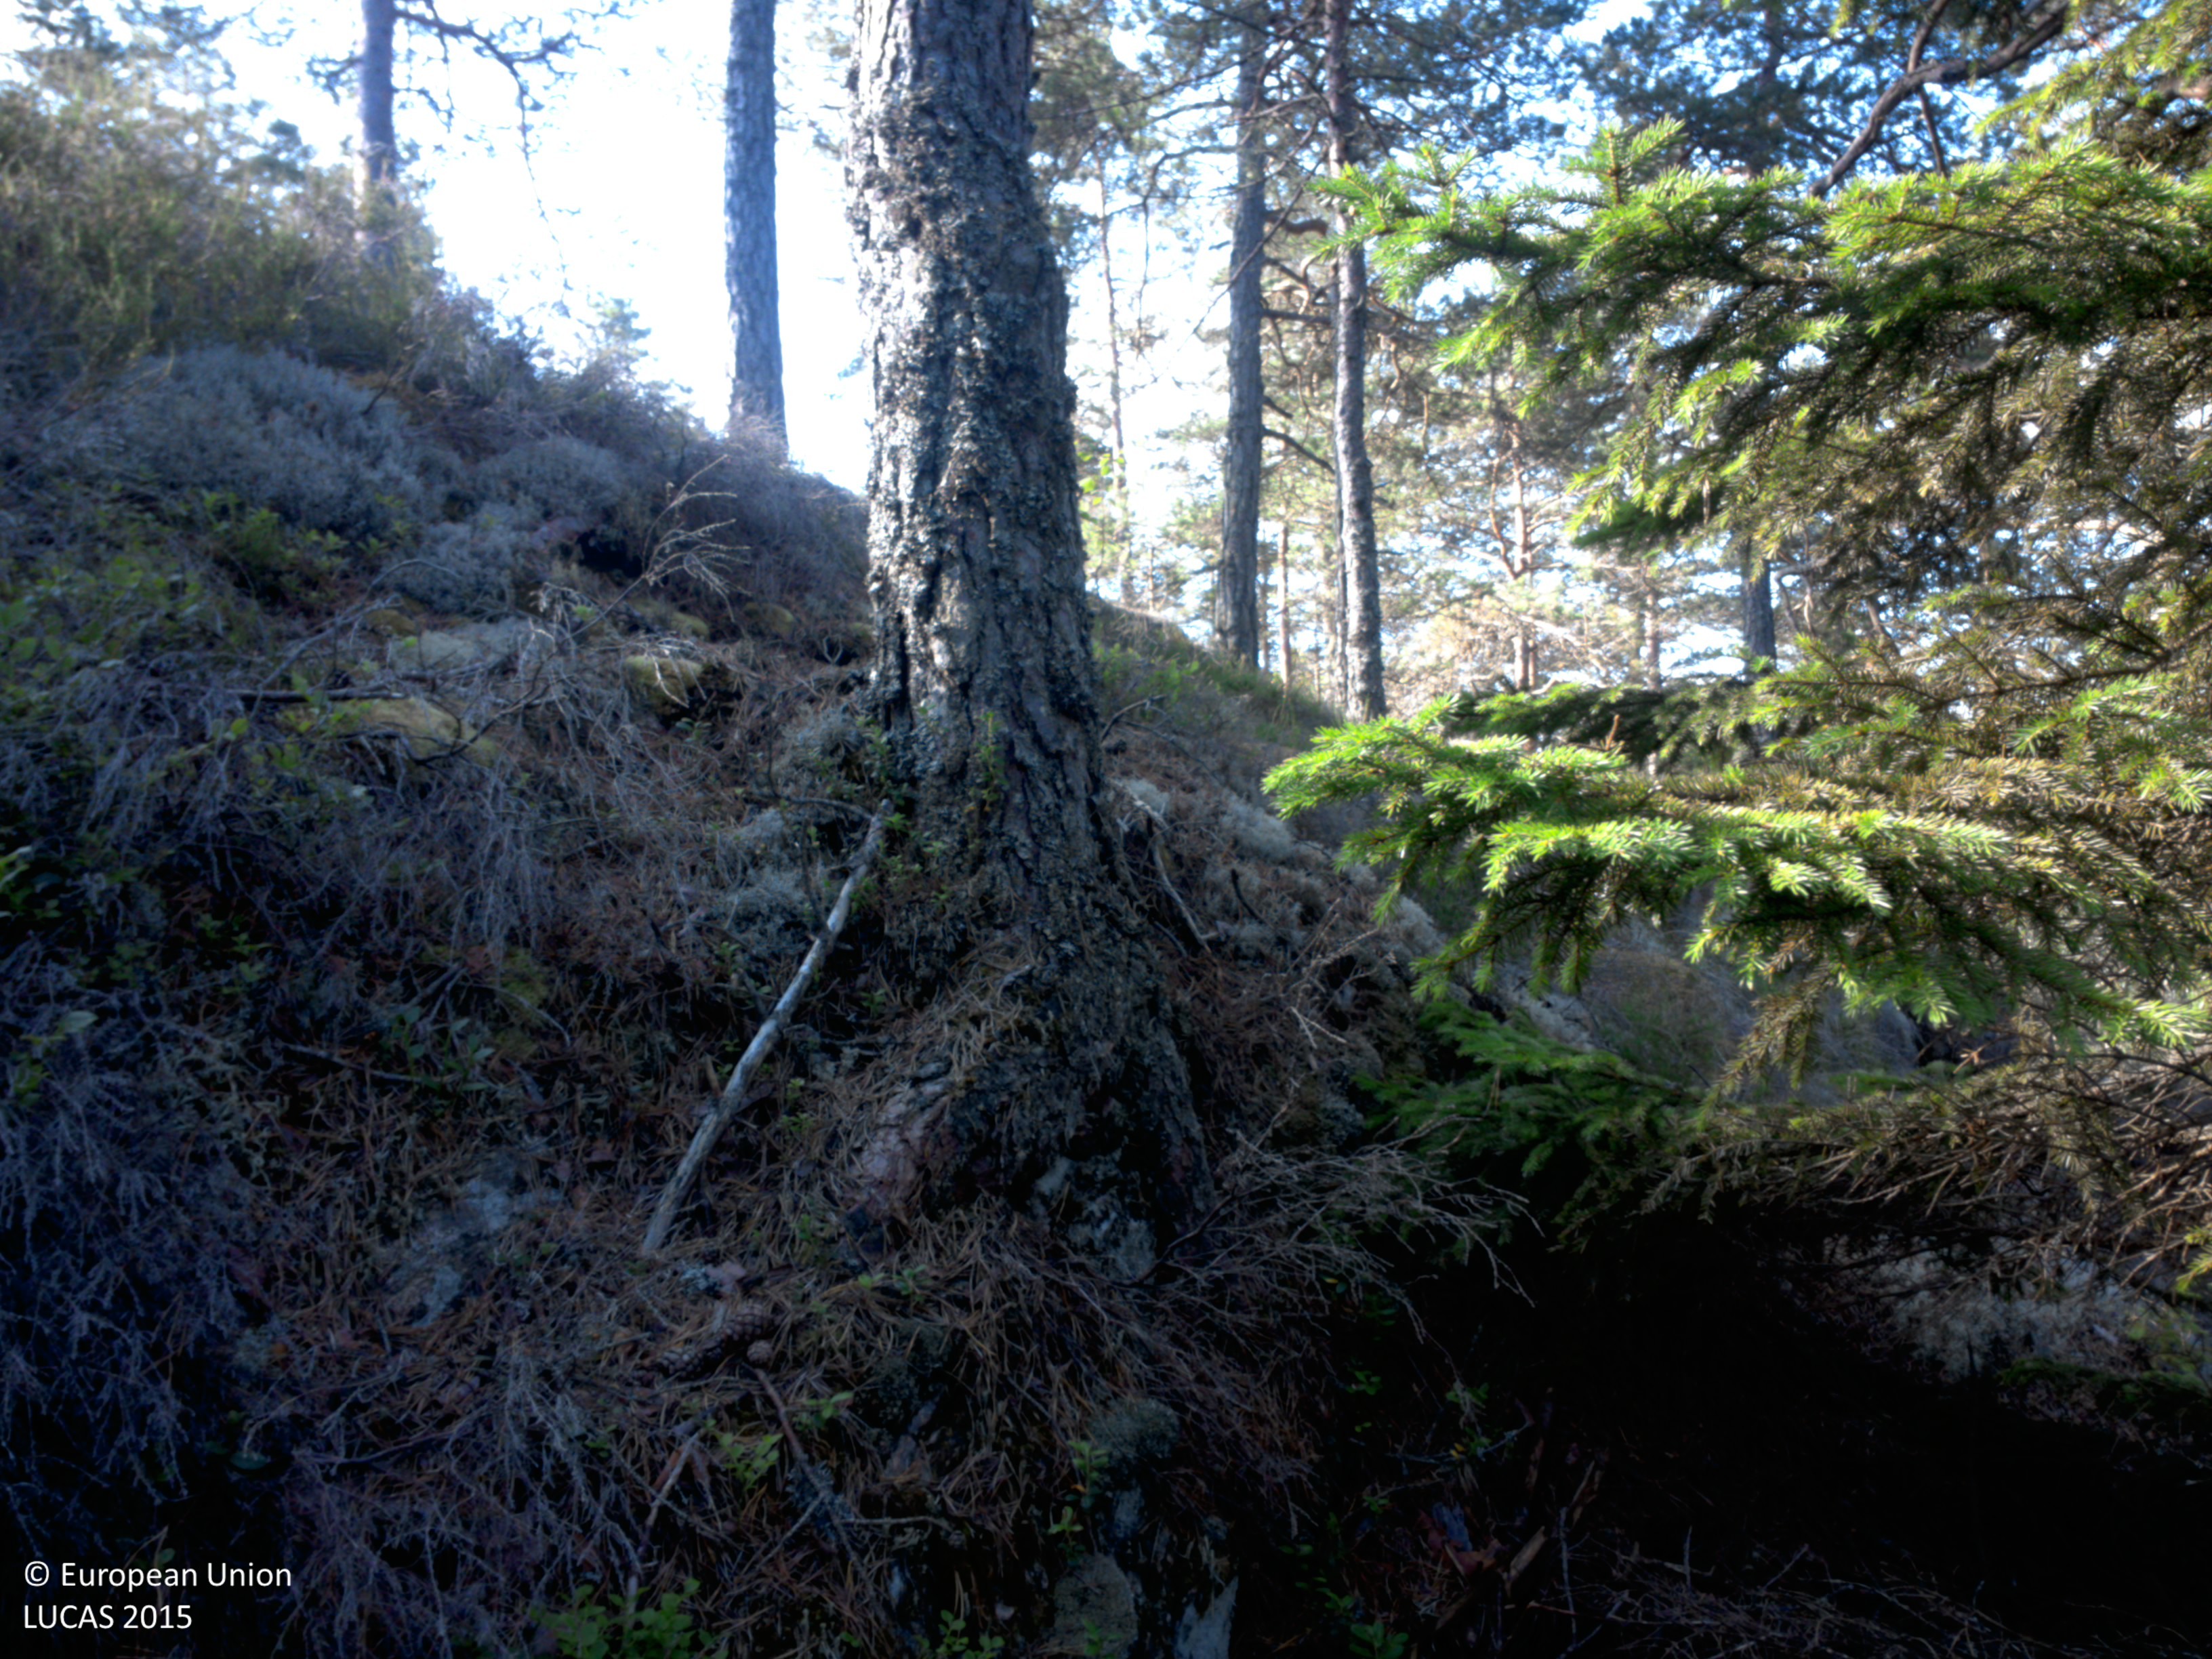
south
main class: Woodland
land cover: Pine dominated coniferous woodland
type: boreal forest
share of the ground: 25 - 50 %
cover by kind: coniferous forest trees 40 %, shrubs 30 %, lichens and mosses 30 %
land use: Forestry
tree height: > 5 m
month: July
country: SE
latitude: 58.8370
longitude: 11.8150
